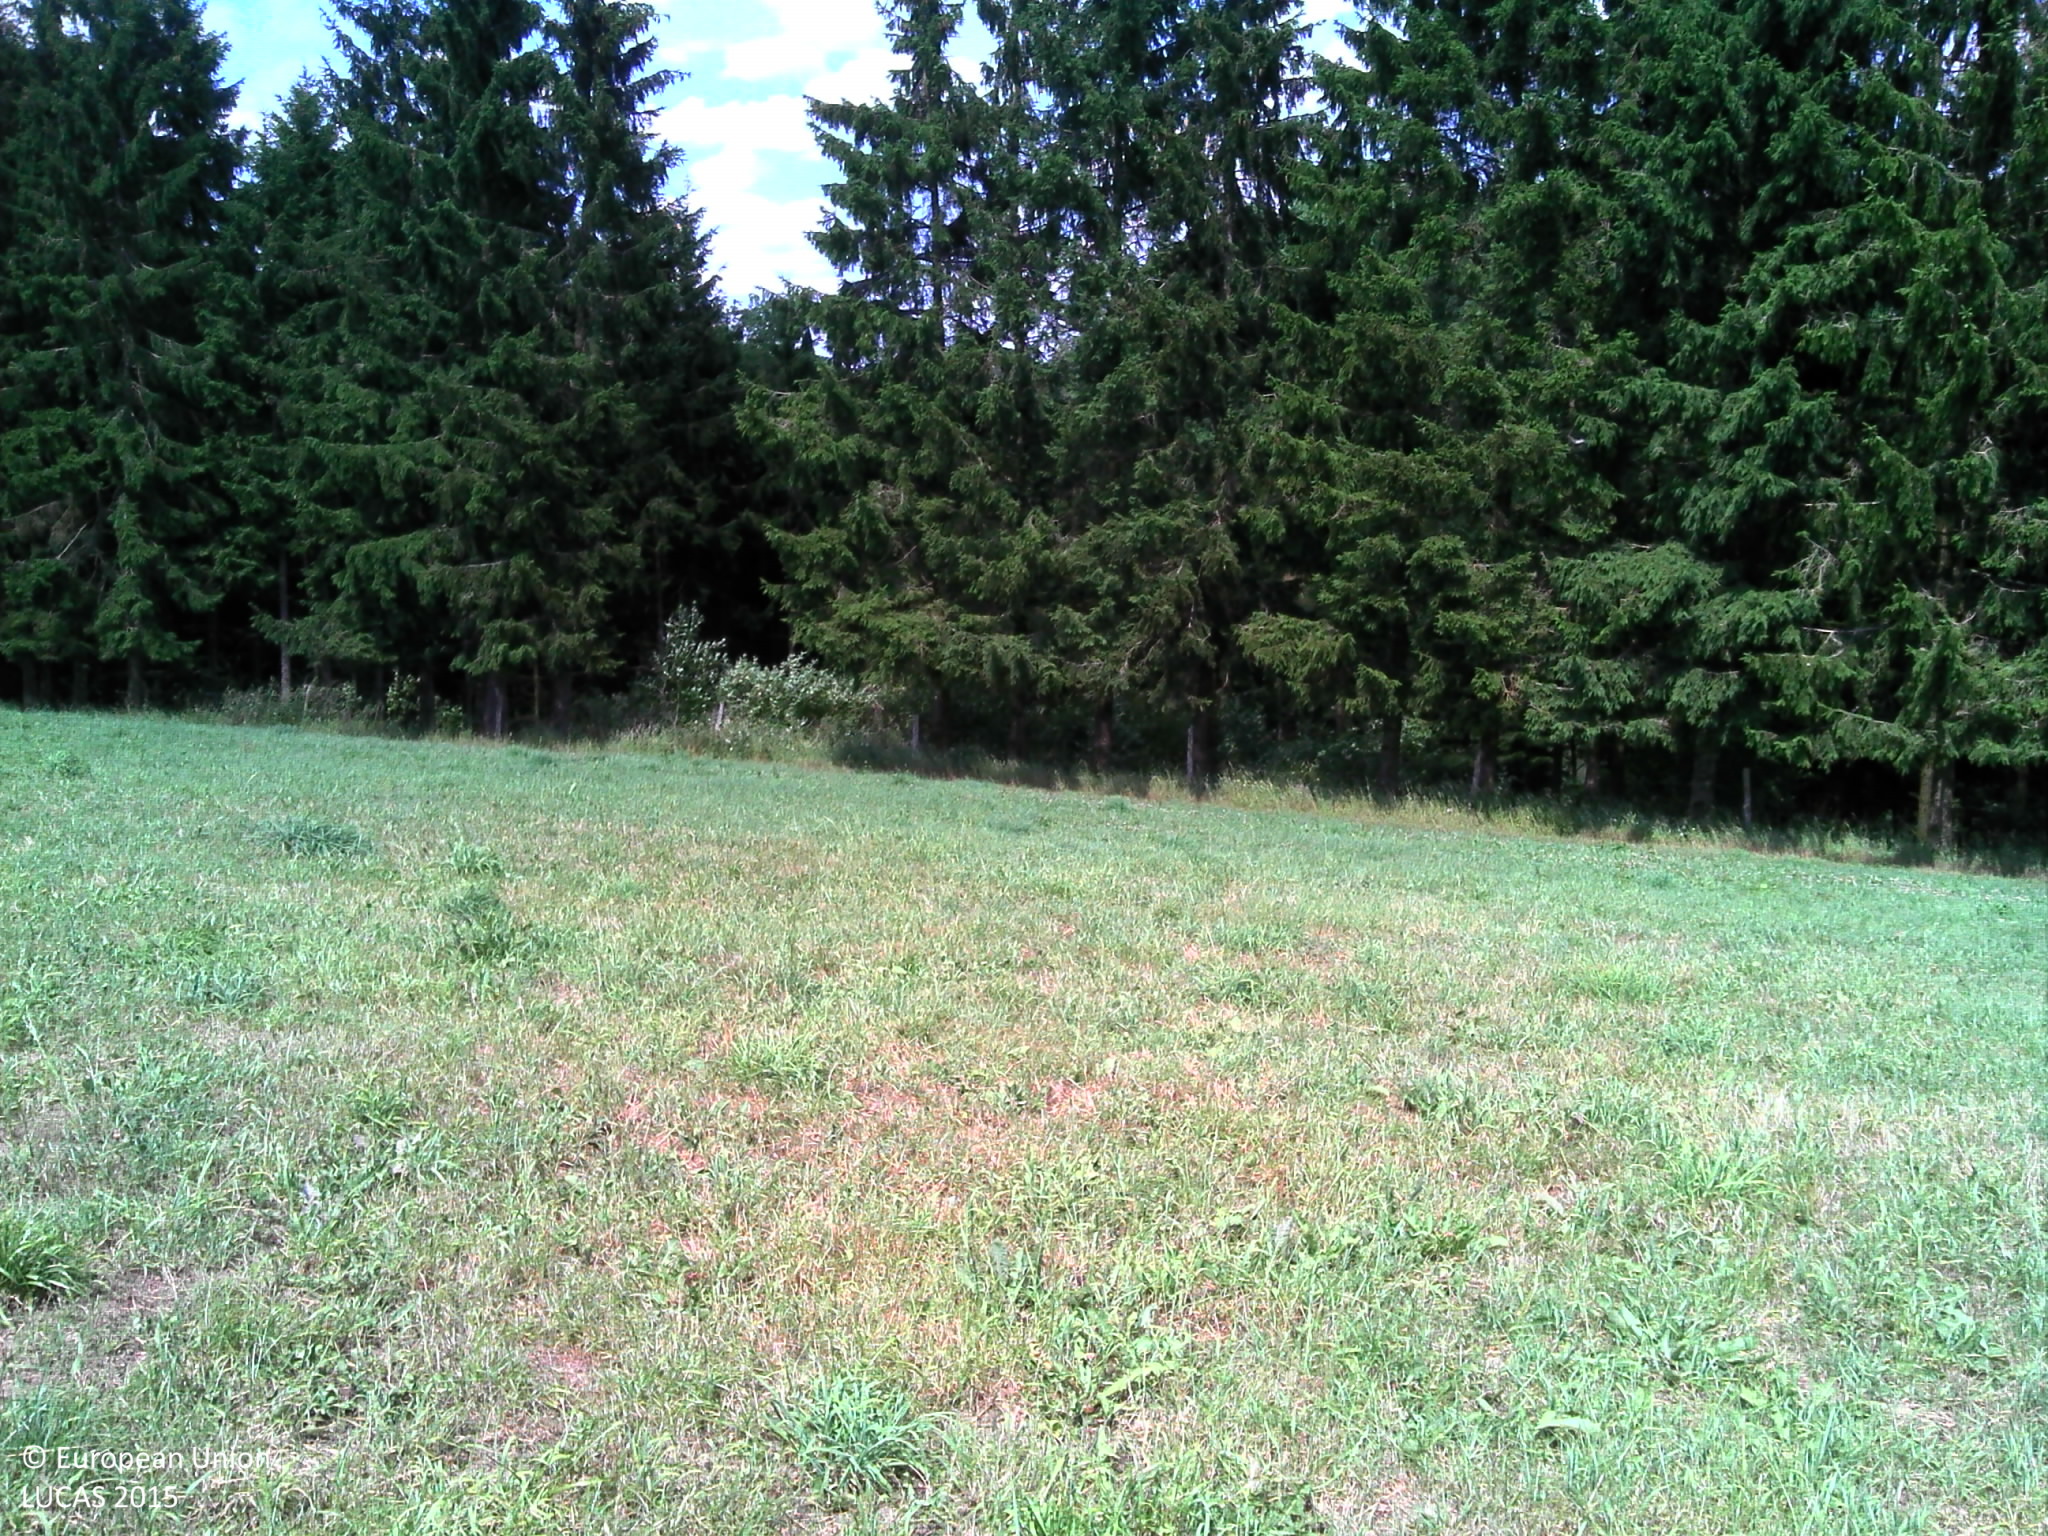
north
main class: Grassland
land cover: Grassland without tree/shrub cover
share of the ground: > 75 %
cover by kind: herbaceous plants 95 %, unconsolidated bare surface 5 %
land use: Agriculture (excluding fallow land and kitchen gardens)
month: July
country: BE
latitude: 49.9250
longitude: 5.7503
